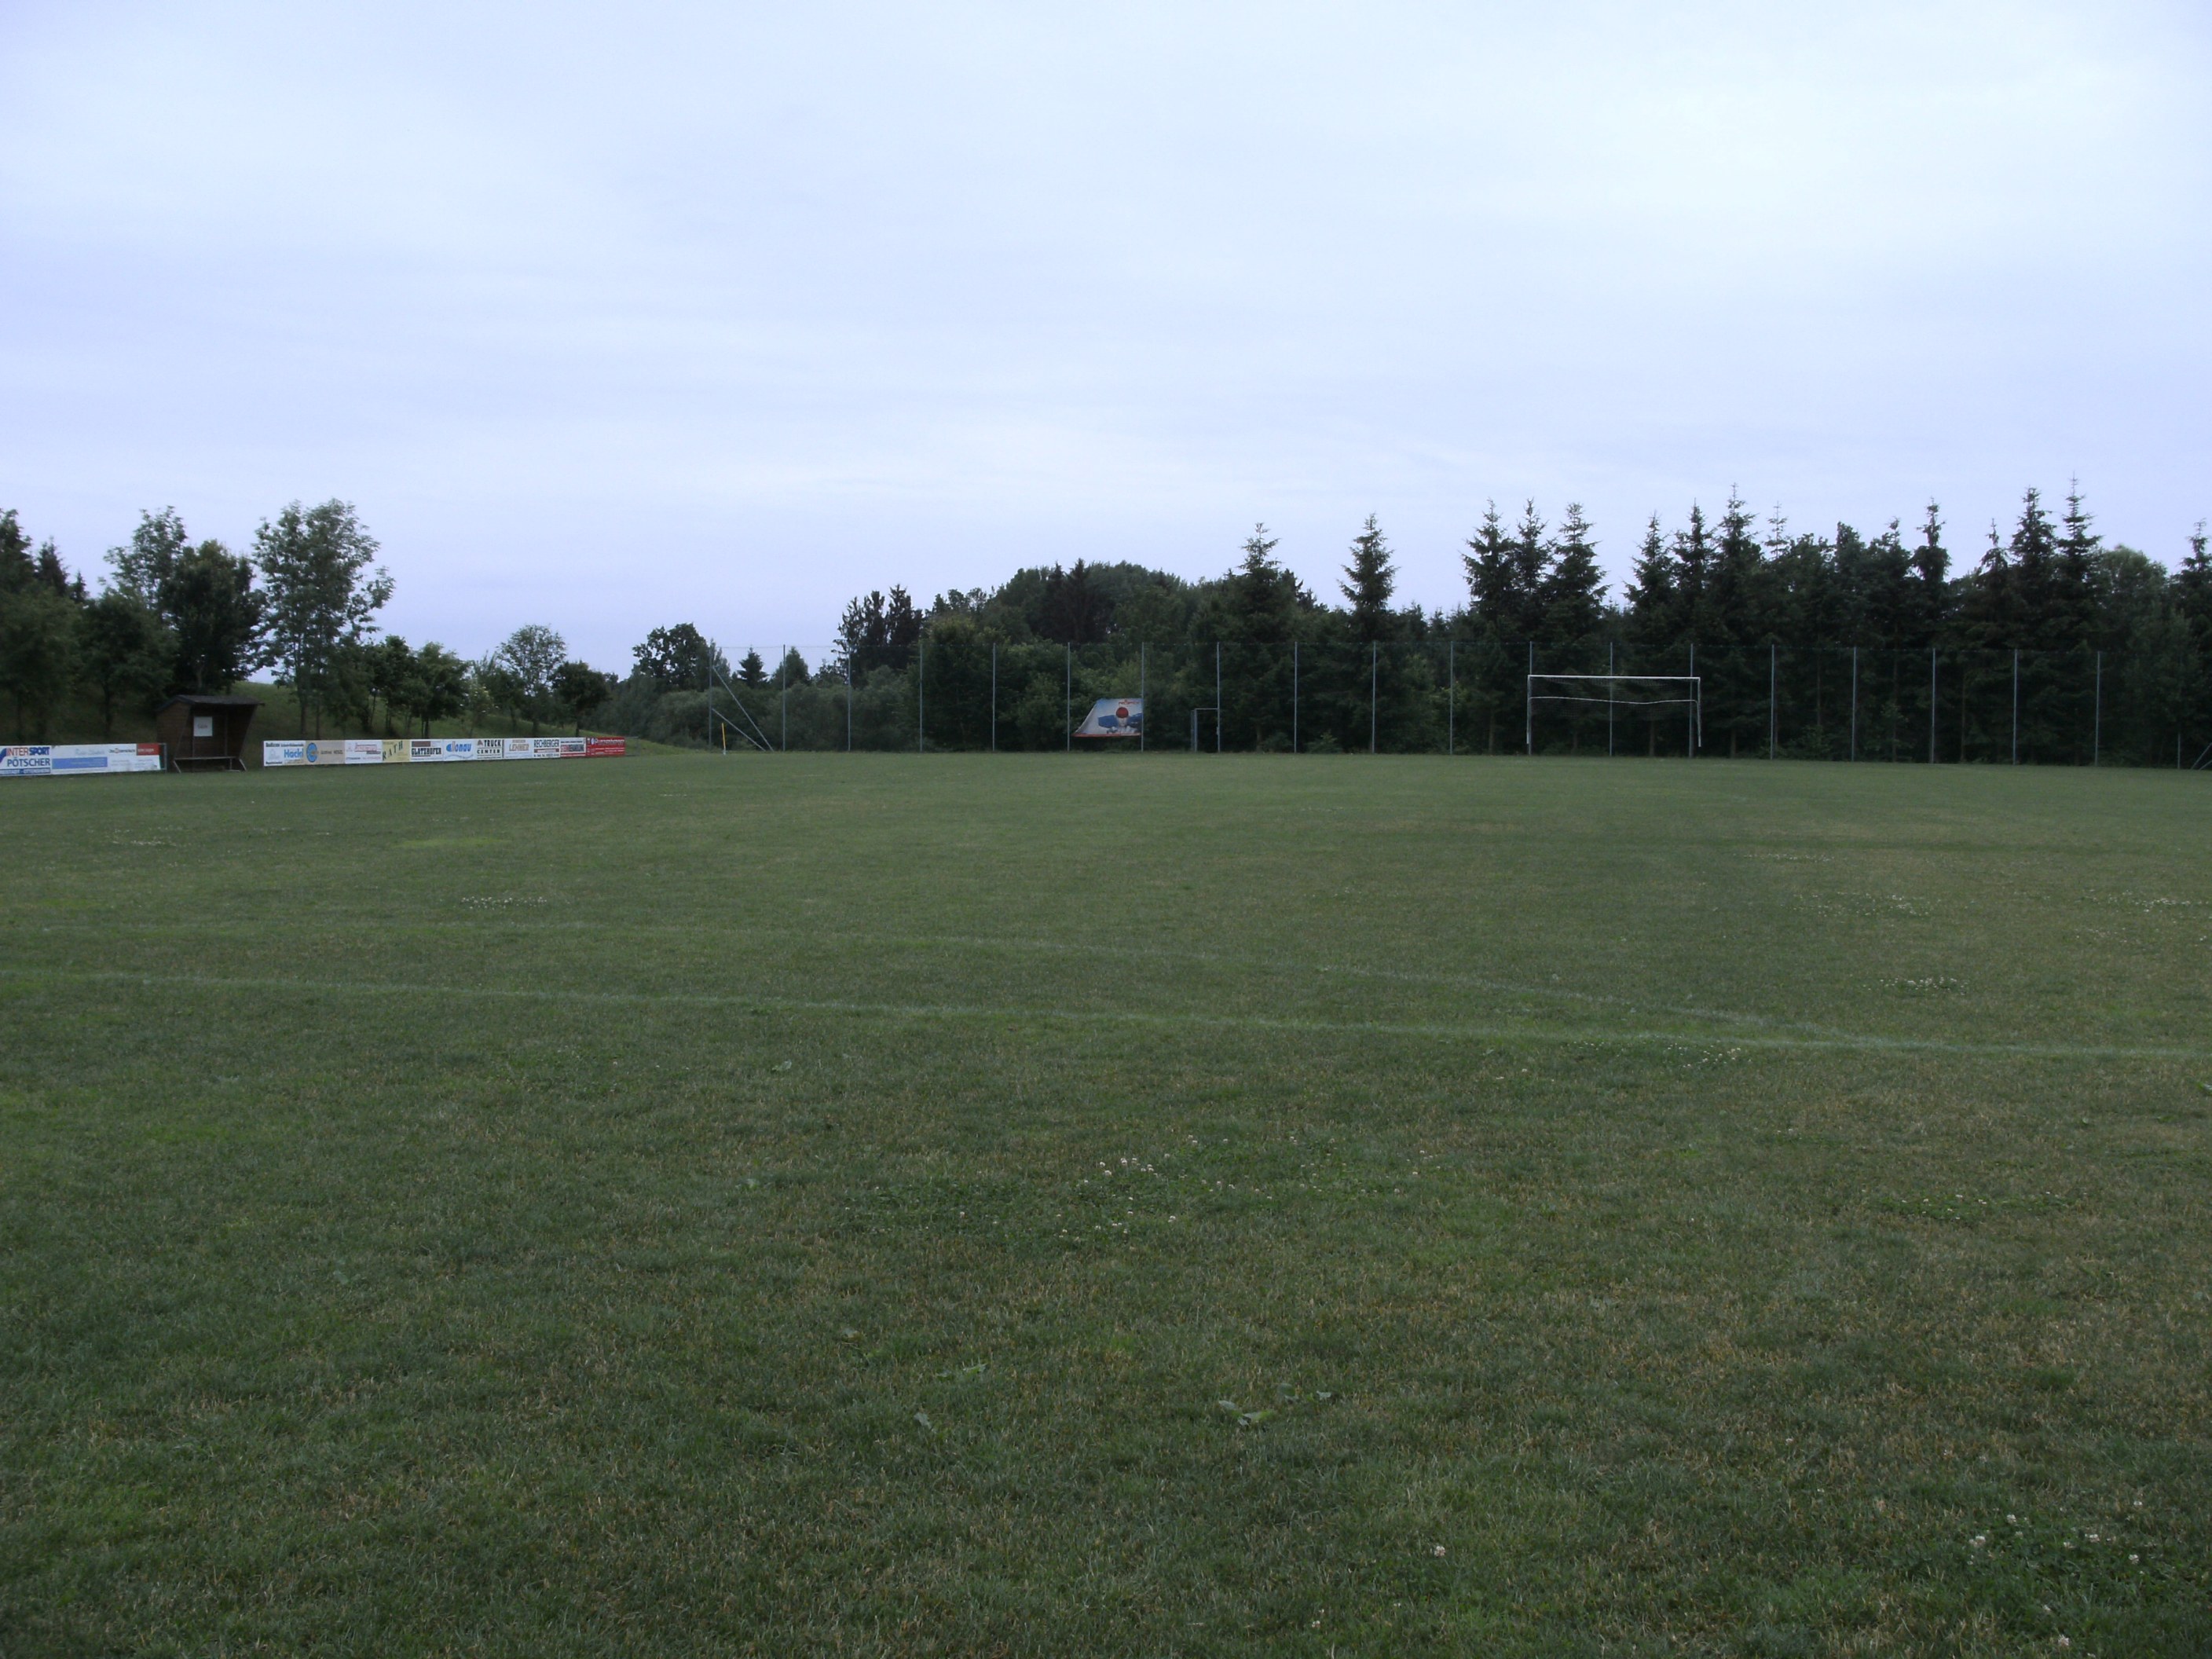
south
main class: Grassland
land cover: Grassland without tree/shrub cover
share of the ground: > 75 %
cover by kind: herbaceous plants 100 %
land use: Sport
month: June
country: AT
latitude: 48.4348
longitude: 14.1226
